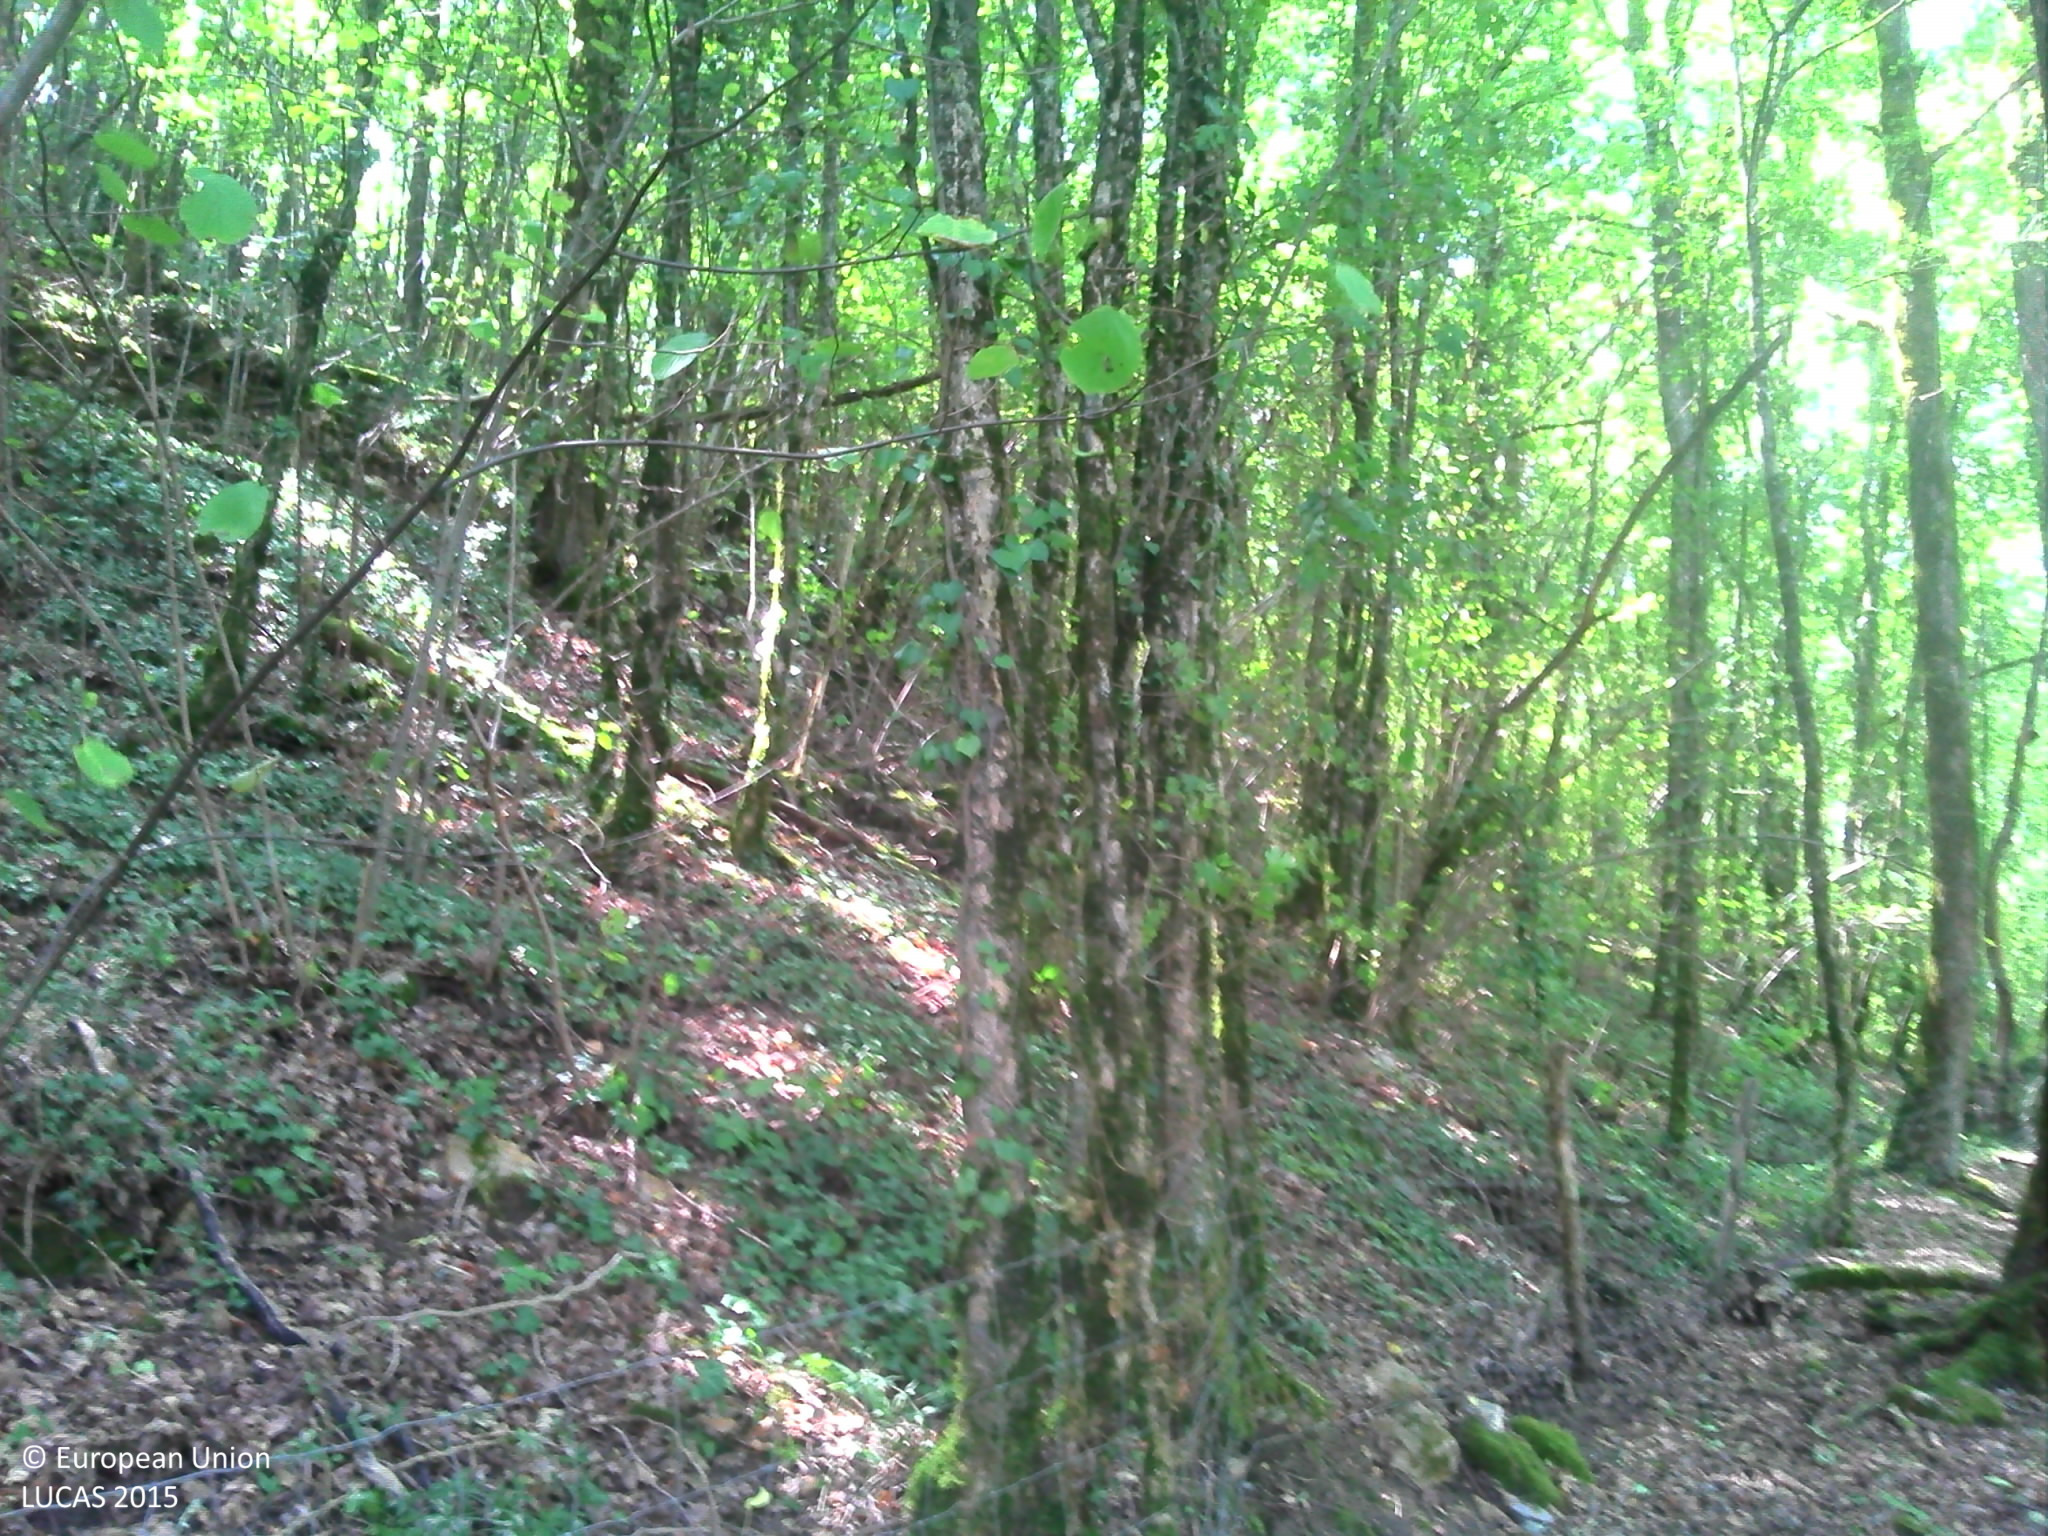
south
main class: Woodland
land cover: Broadleaved woodland
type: thermophilous deciduous forest
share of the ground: > 75 %
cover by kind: broadleaved forest trees 90 %, herbaceous plants 5 %, lichens and mosses 5 %
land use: Forestry
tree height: > 5 m
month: August
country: FR
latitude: 44.8618
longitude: 1.8354
